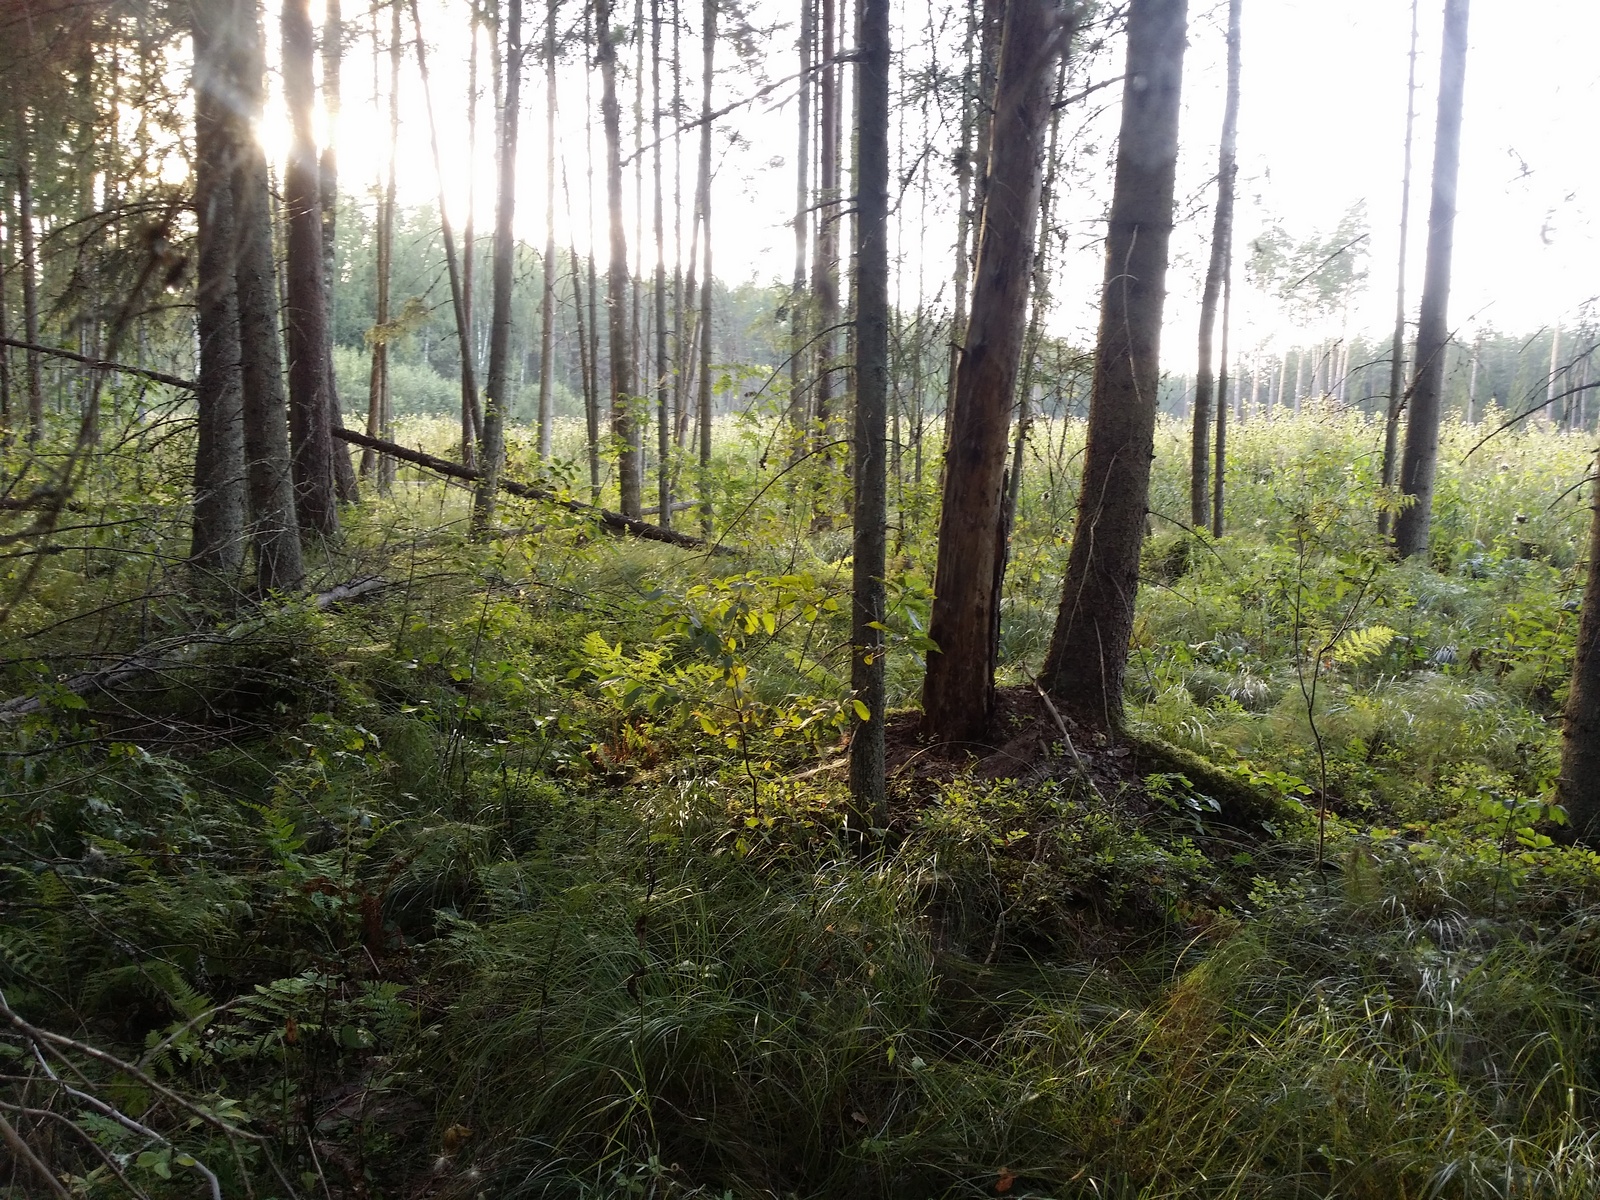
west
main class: Woodland
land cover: Other mixed woodland
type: hemiboreal forest and nemoral coniferous forest and mixed broadleaved-coniferous forest
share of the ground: > 75 %
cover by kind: coniferous forest trees 55 %, broadleaved forest trees 25 %, herbaceous plants 10 %, lichens and mosses 10 %
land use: Forestry
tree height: > 5 m
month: August
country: LV
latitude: 57.5017
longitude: 26.7891
